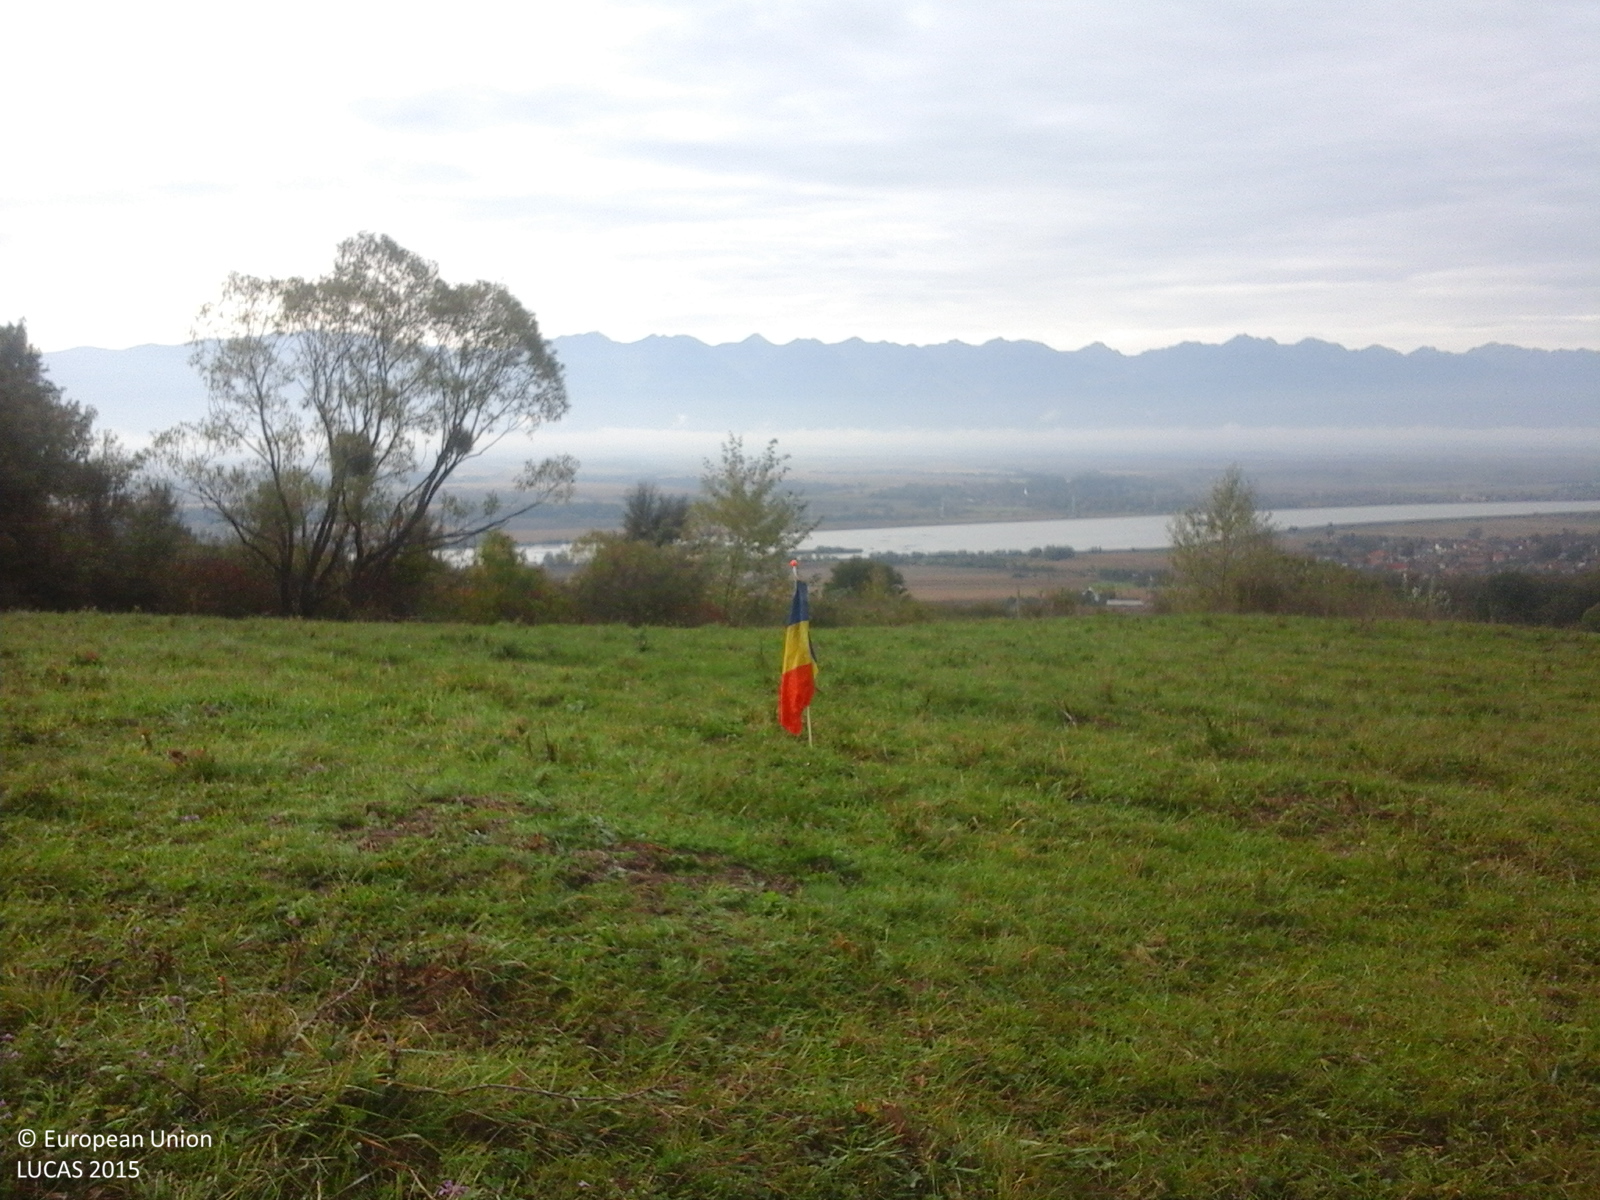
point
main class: Grassland
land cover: Grassland without tree/shrub cover
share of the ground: > 75 %
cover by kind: herbaceous plants 100 %
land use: Agriculture (excluding fallow land and kitchen gardens)
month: October
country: RO
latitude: 45.8304
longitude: 24.7759
